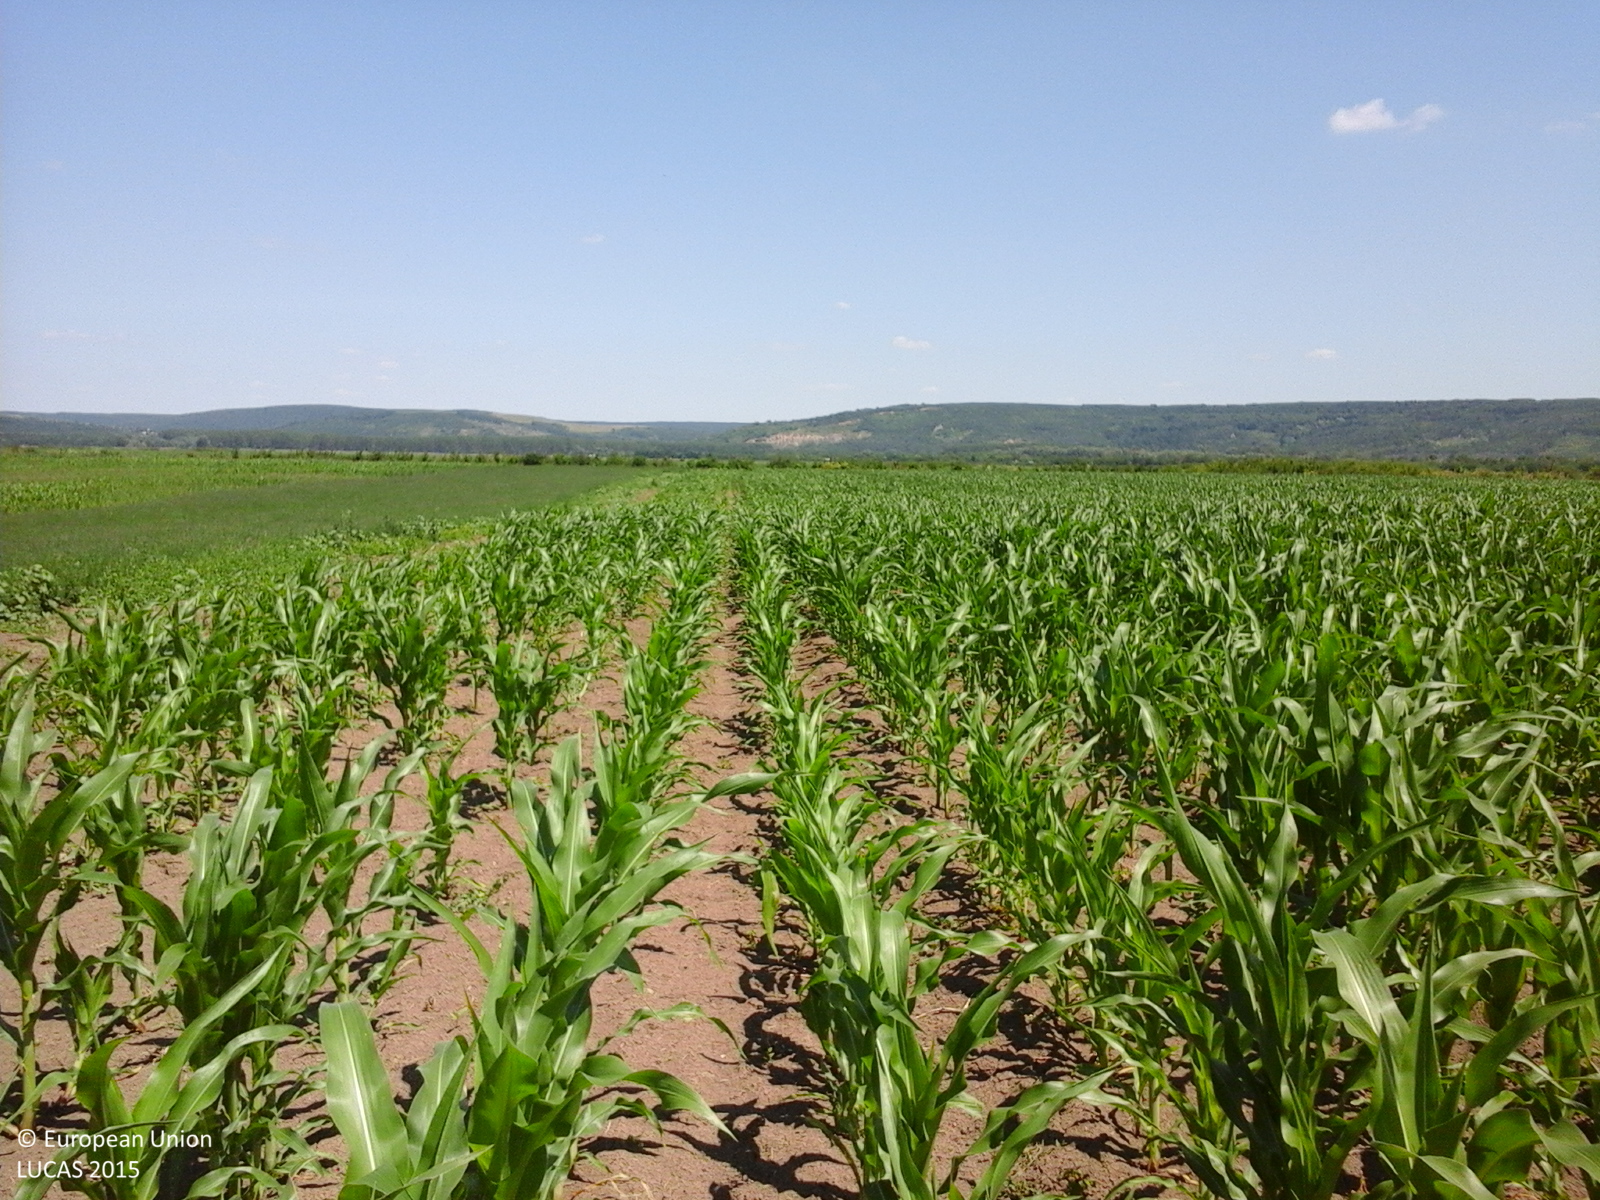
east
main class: Cropland
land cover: Maize
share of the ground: 50 - 75 %
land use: Agriculture (excluding fallow land and kitchen gardens)
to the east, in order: Maize; Abandoned hedges; Ditches and canals; Abandoned hedges; Sunflower
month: June
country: RO
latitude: 47.4481
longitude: 27.5321
